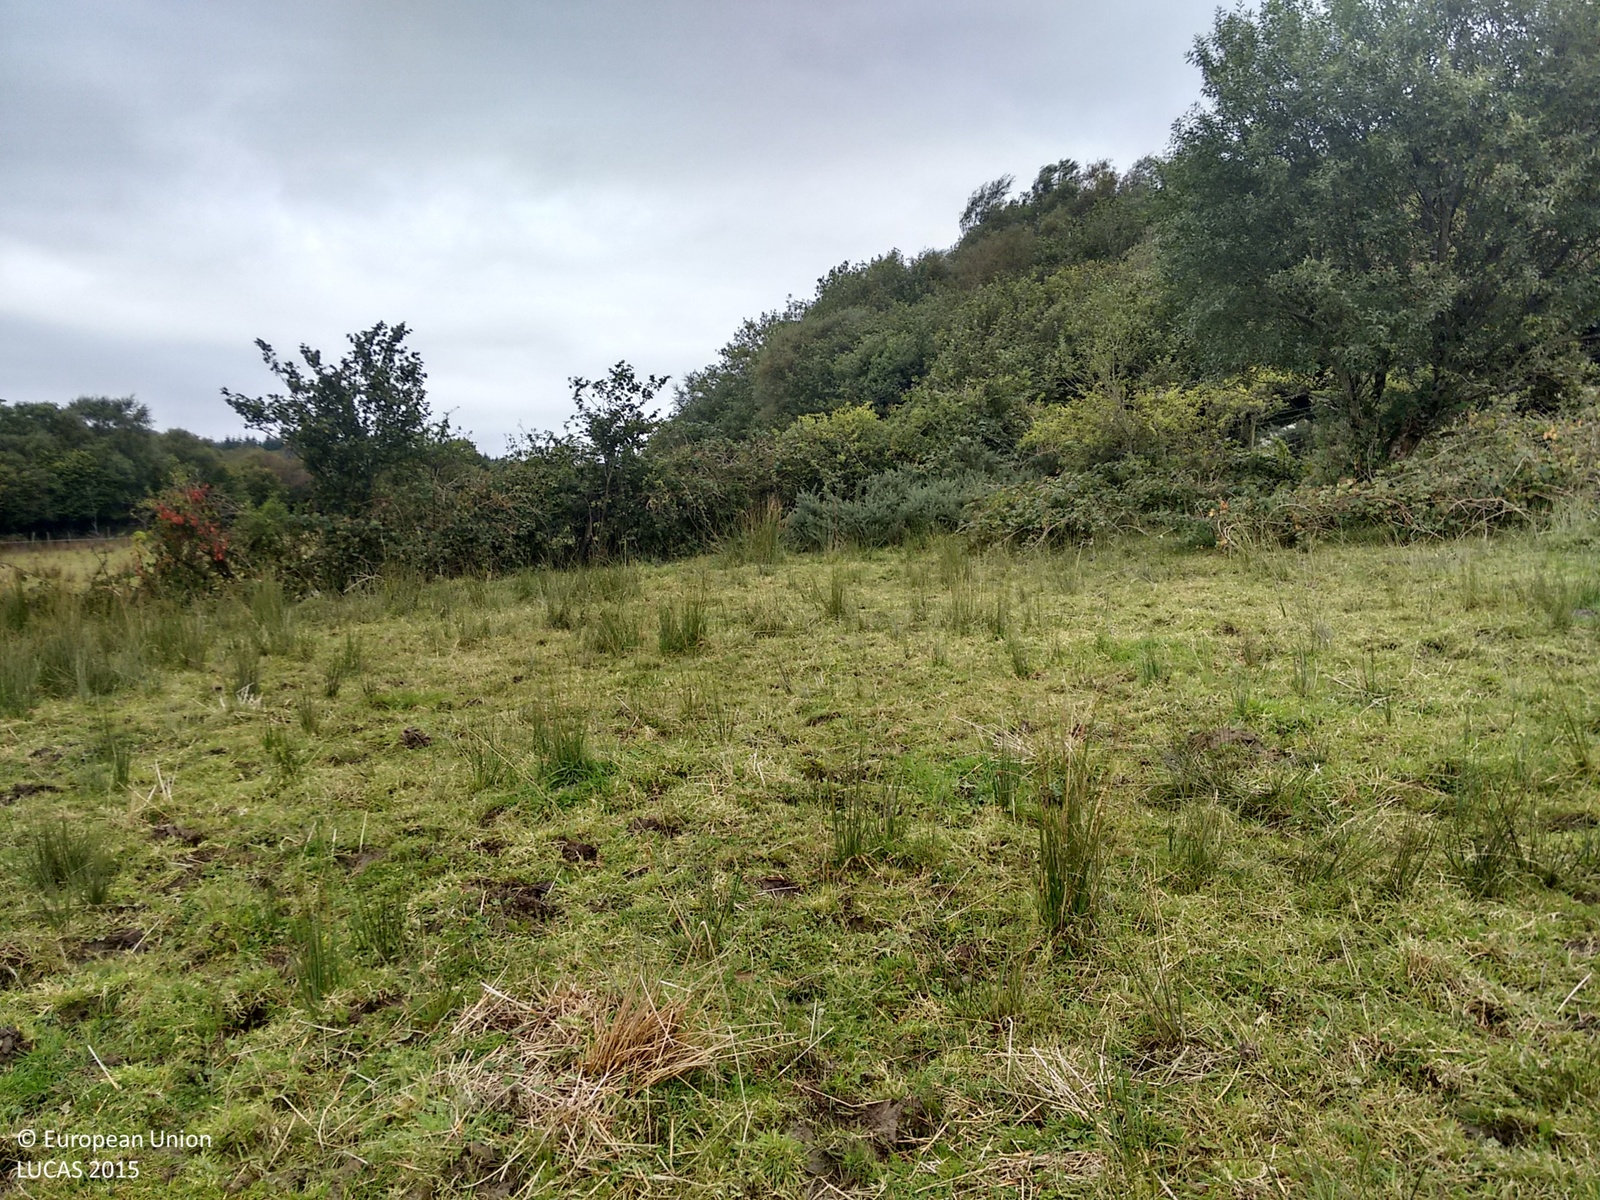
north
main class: Grassland
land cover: Grassland without tree/shrub cover
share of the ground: > 75 %
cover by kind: herbaceous plants 100 %
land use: Agriculture (excluding fallow land and kitchen gardens)
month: September
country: IE
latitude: 55.0775
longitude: -7.6548
